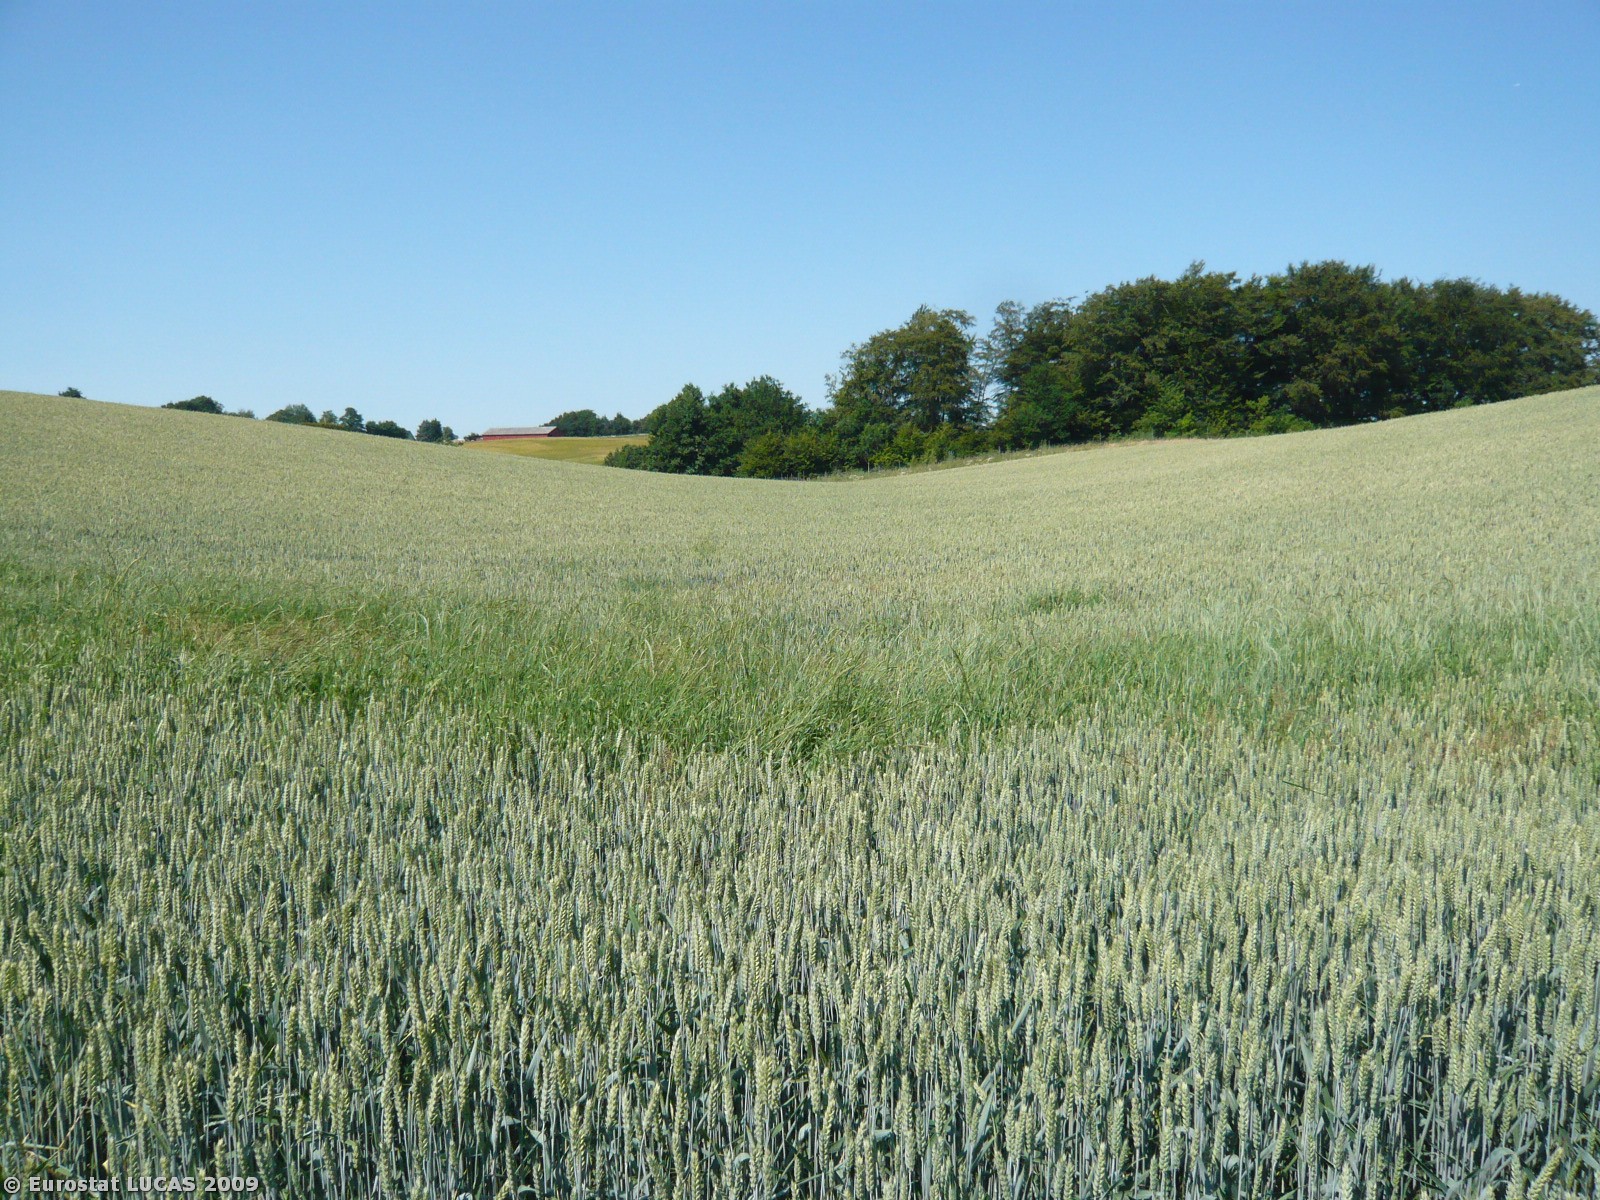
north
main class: Cropland
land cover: Common wheat
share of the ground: > 75 %
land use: Agriculture (excluding fallow land and kitchen gardens)
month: July
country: DK
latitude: 55.3968
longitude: 10.1420
